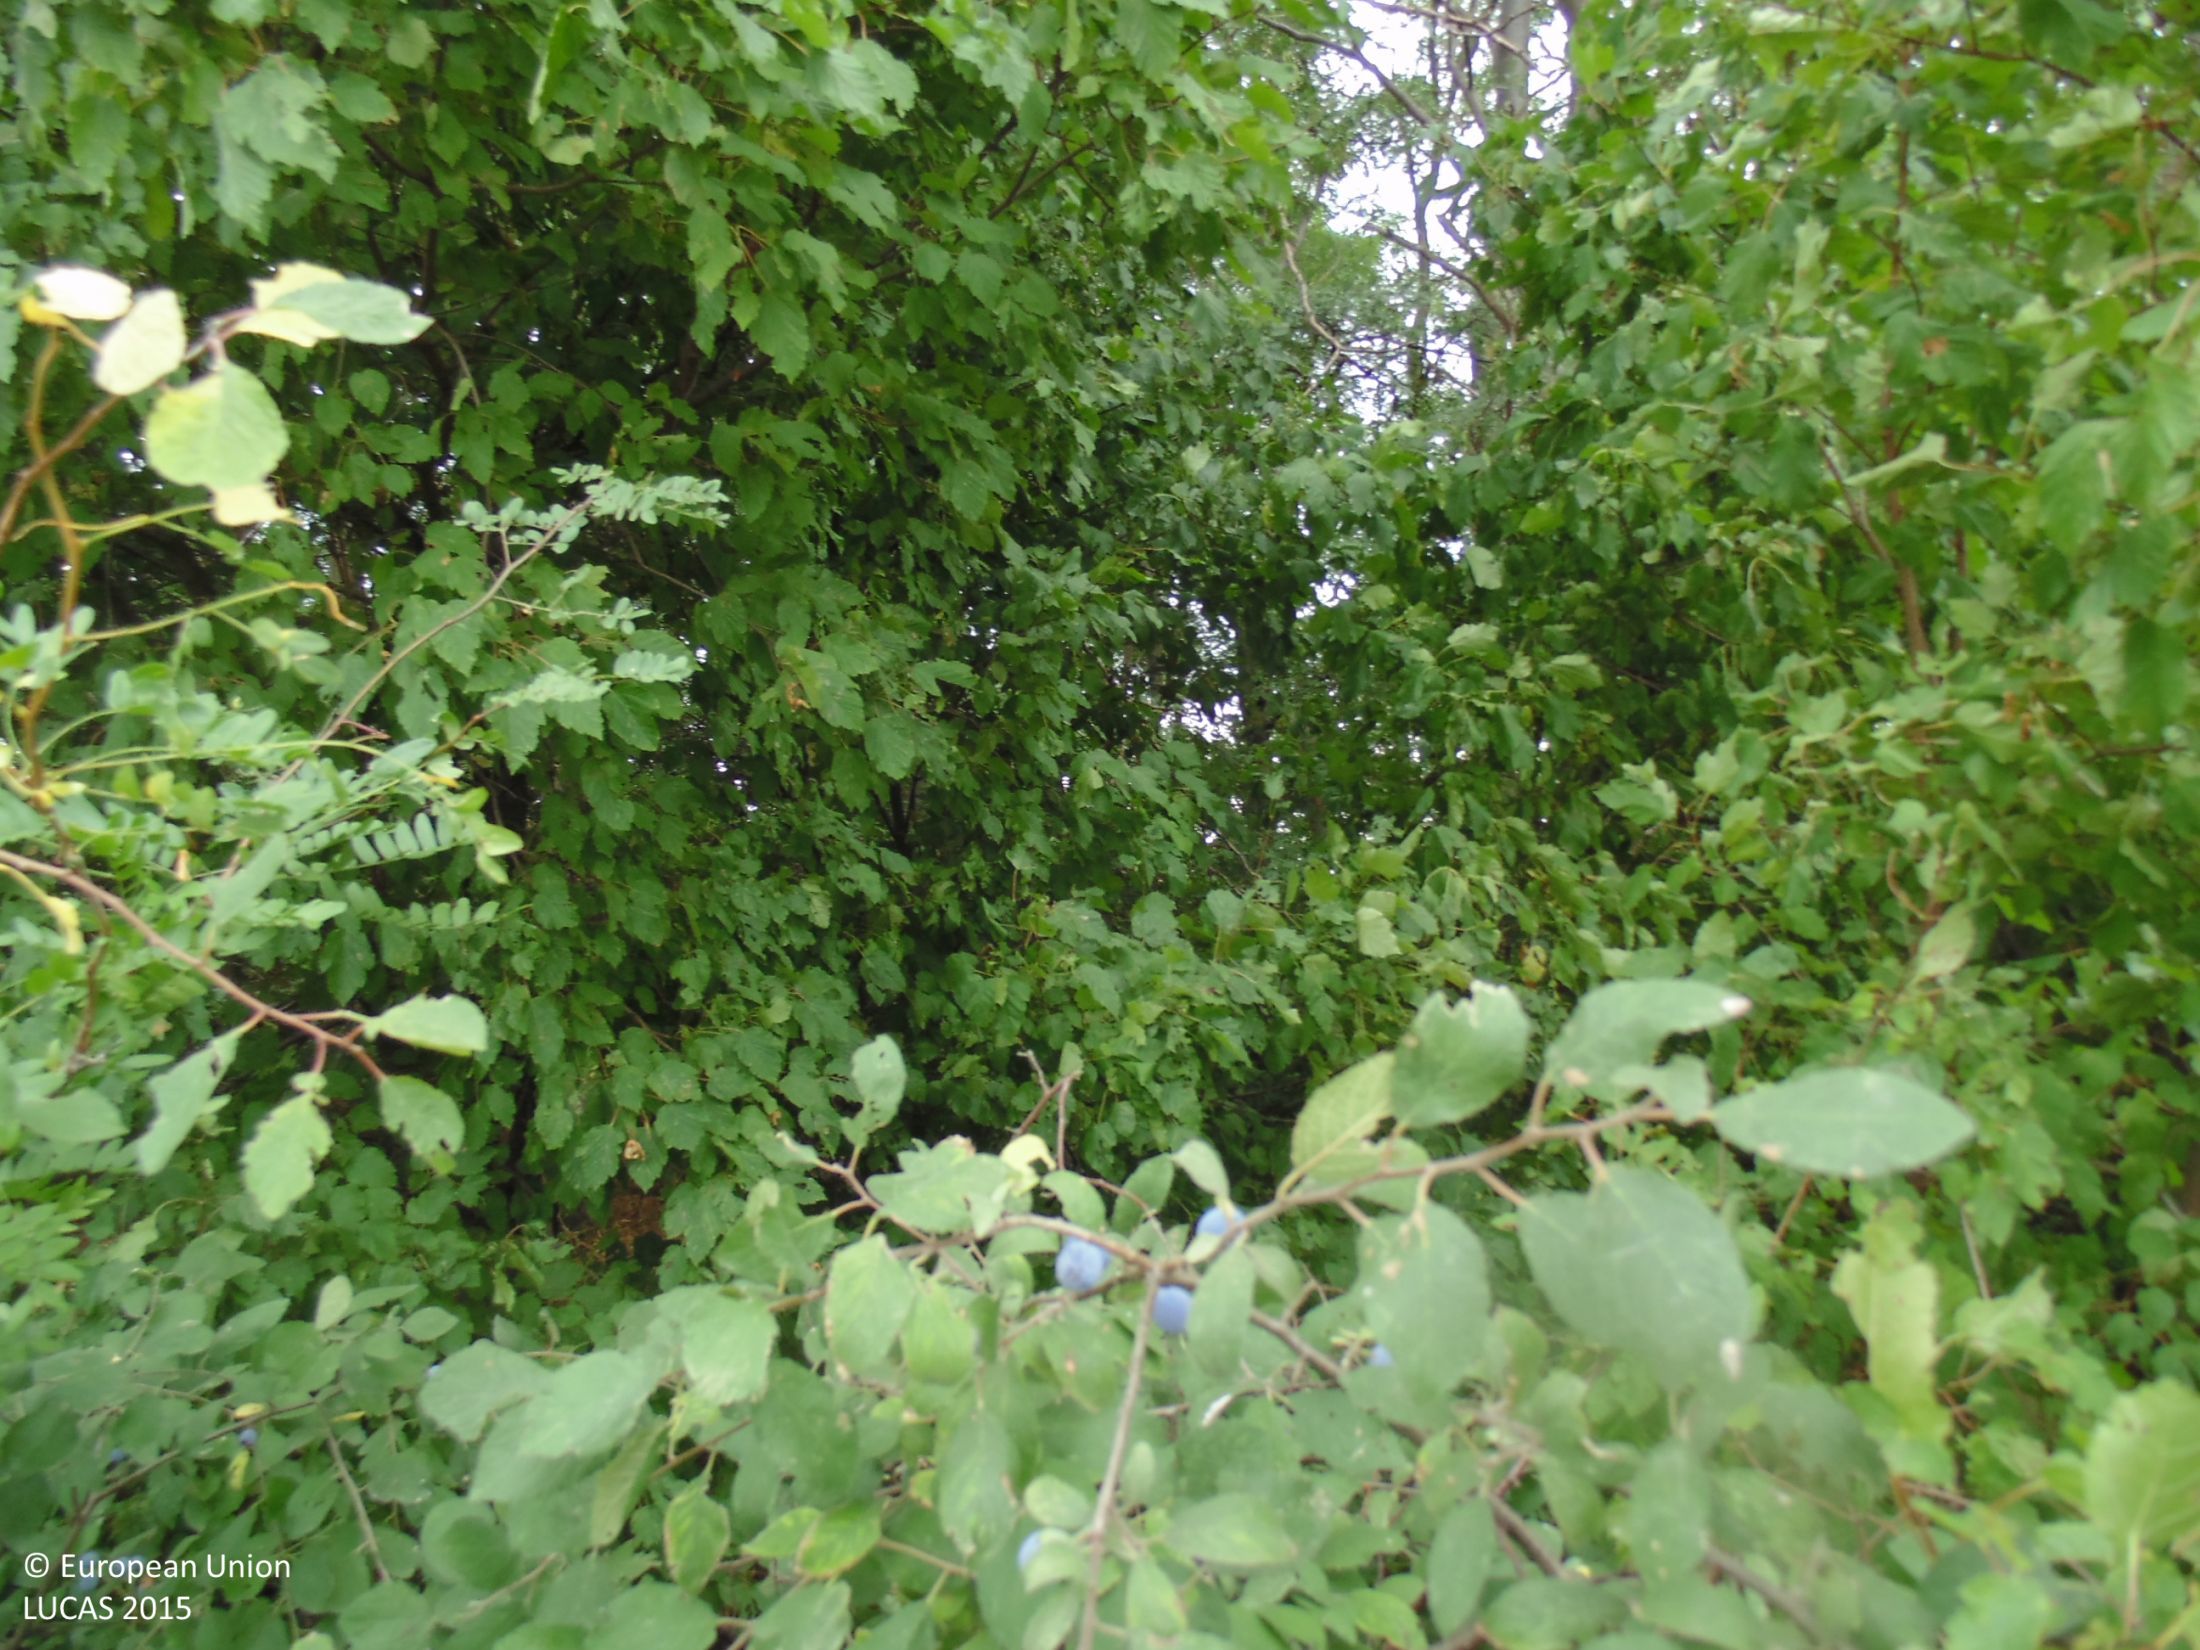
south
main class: Woodland
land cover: Broadleaved woodland
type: mesophytic deciduous forest
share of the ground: > 75 %
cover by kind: broadleaved forest trees 90 %, shrubs 10 %
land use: Forestry
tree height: > 5 m
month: August
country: BG
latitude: 43.5784
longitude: 28.4765
